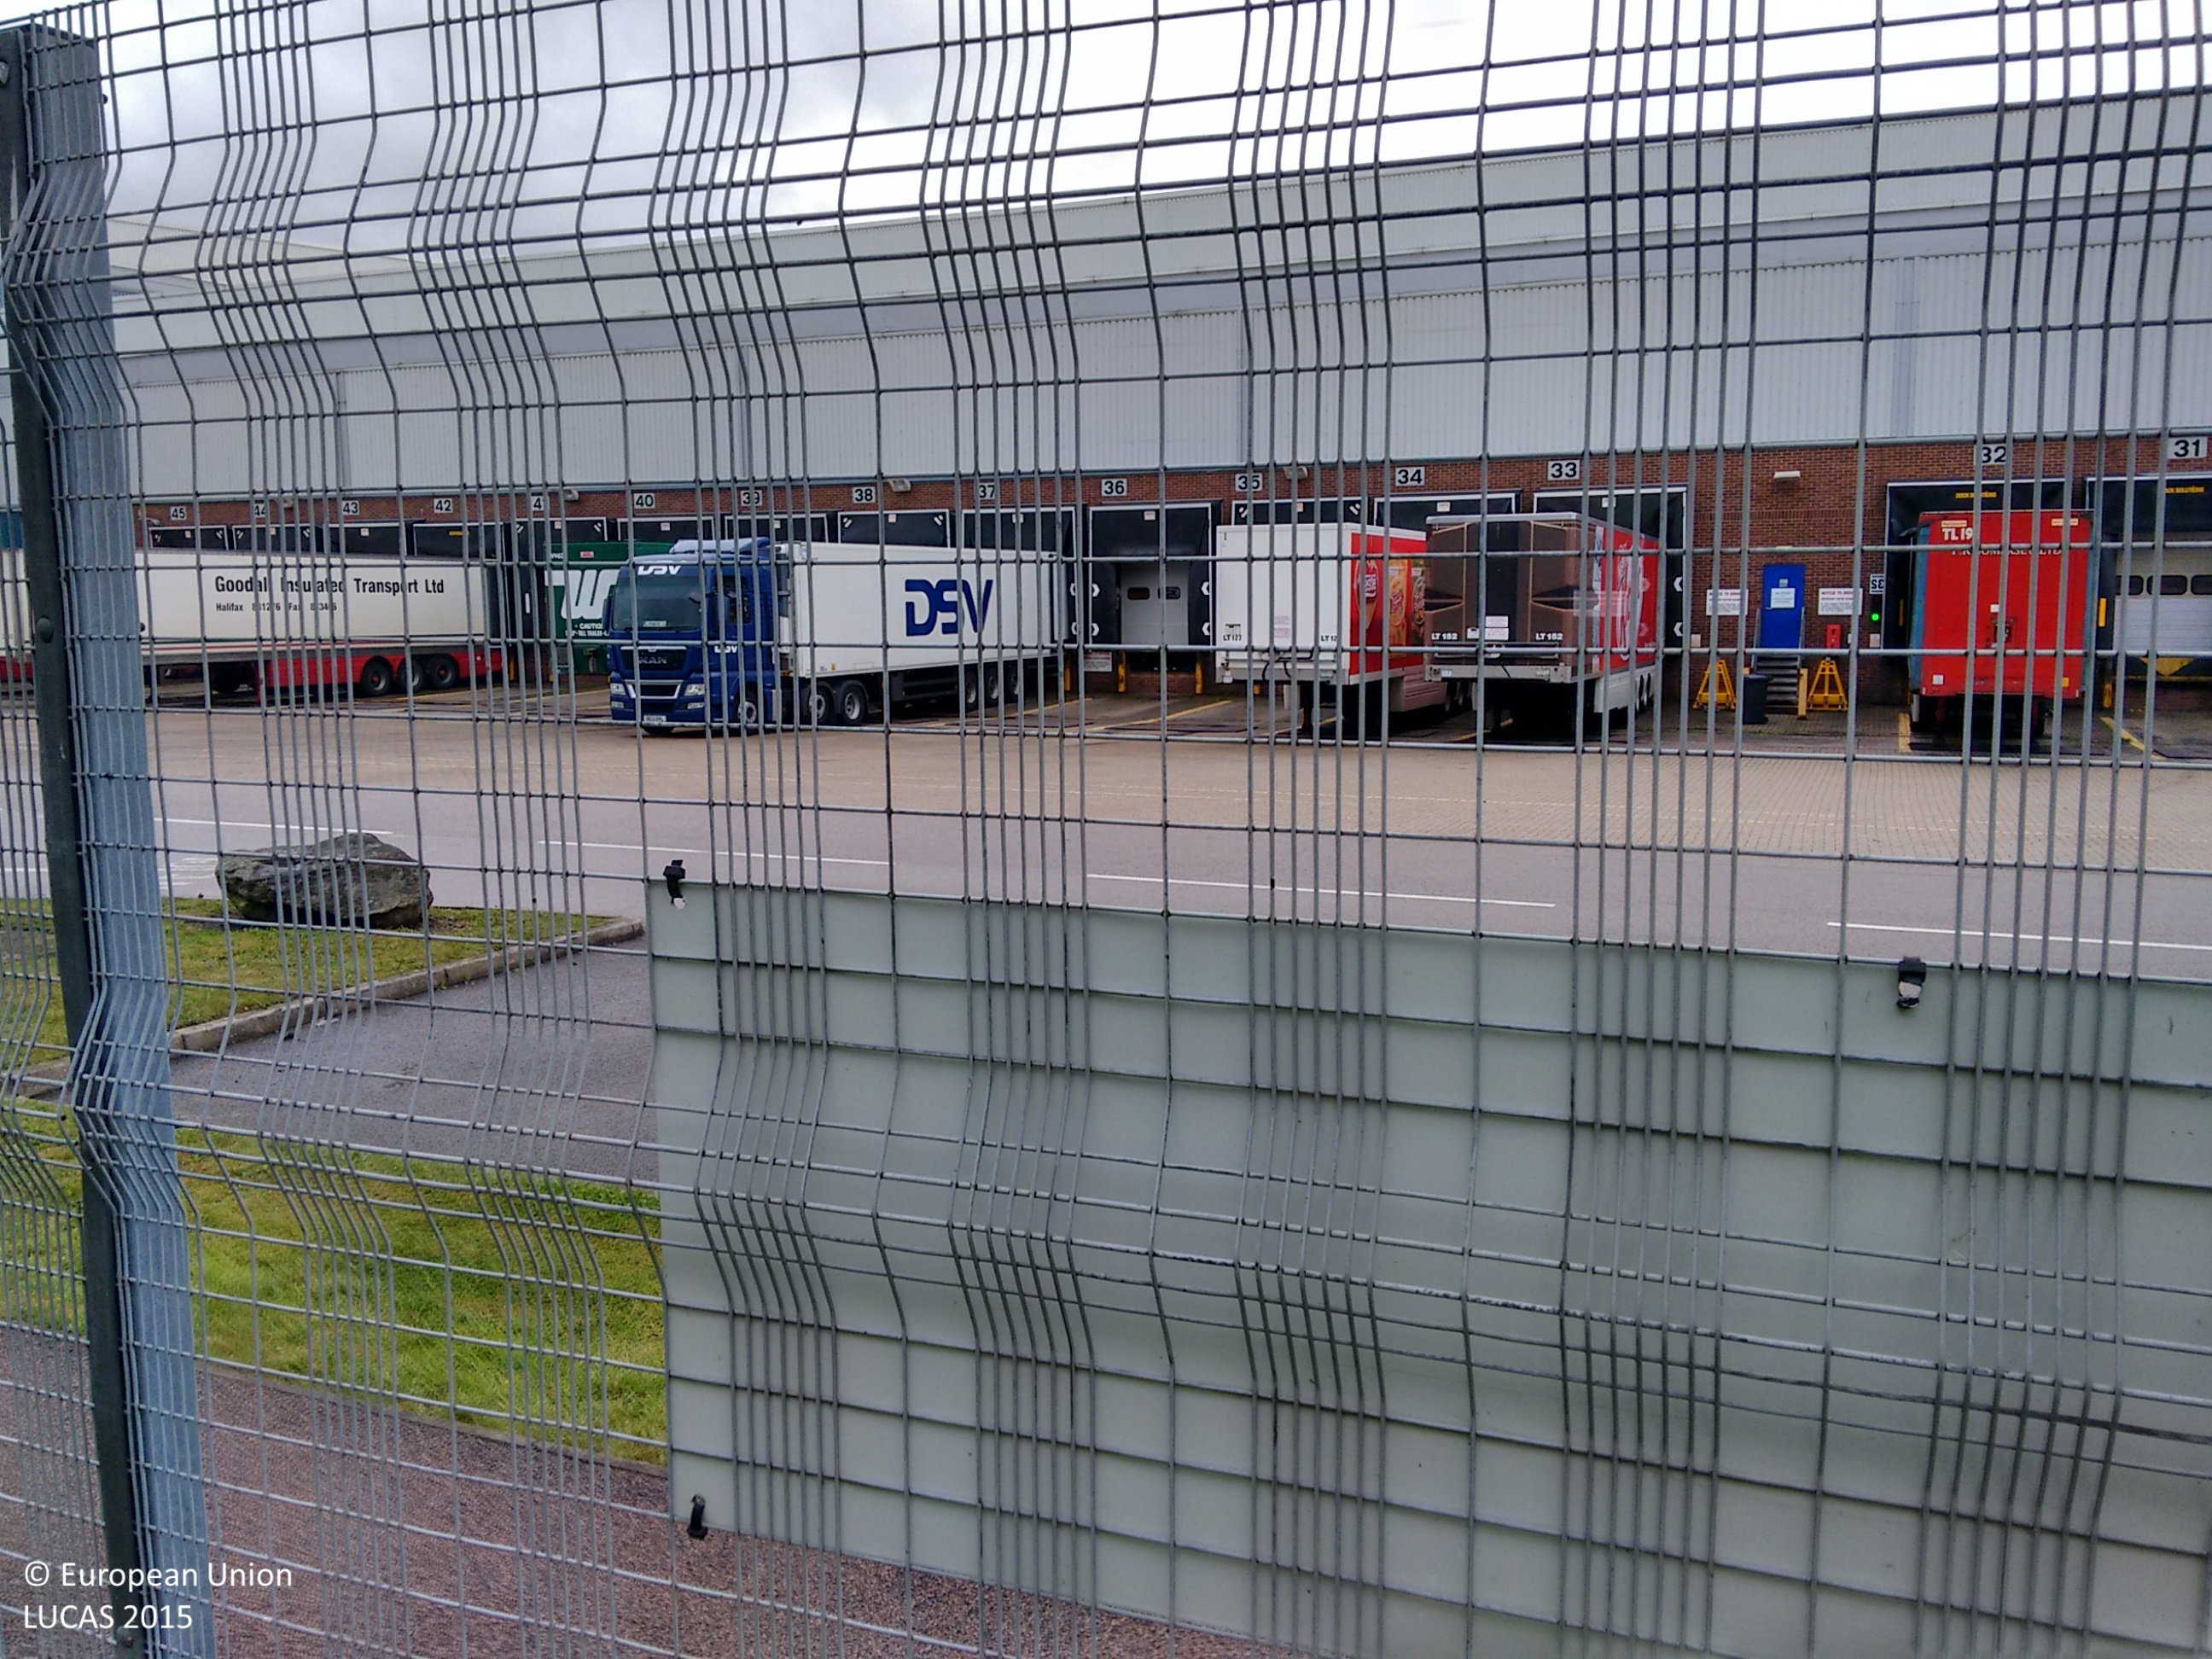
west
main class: Grassland
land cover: Grassland without tree/shrub cover
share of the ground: > 75 %
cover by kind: herbaceous plants 100 %
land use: Logistics and storage
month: August
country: GB
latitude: 52.7038
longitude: -1.3405
